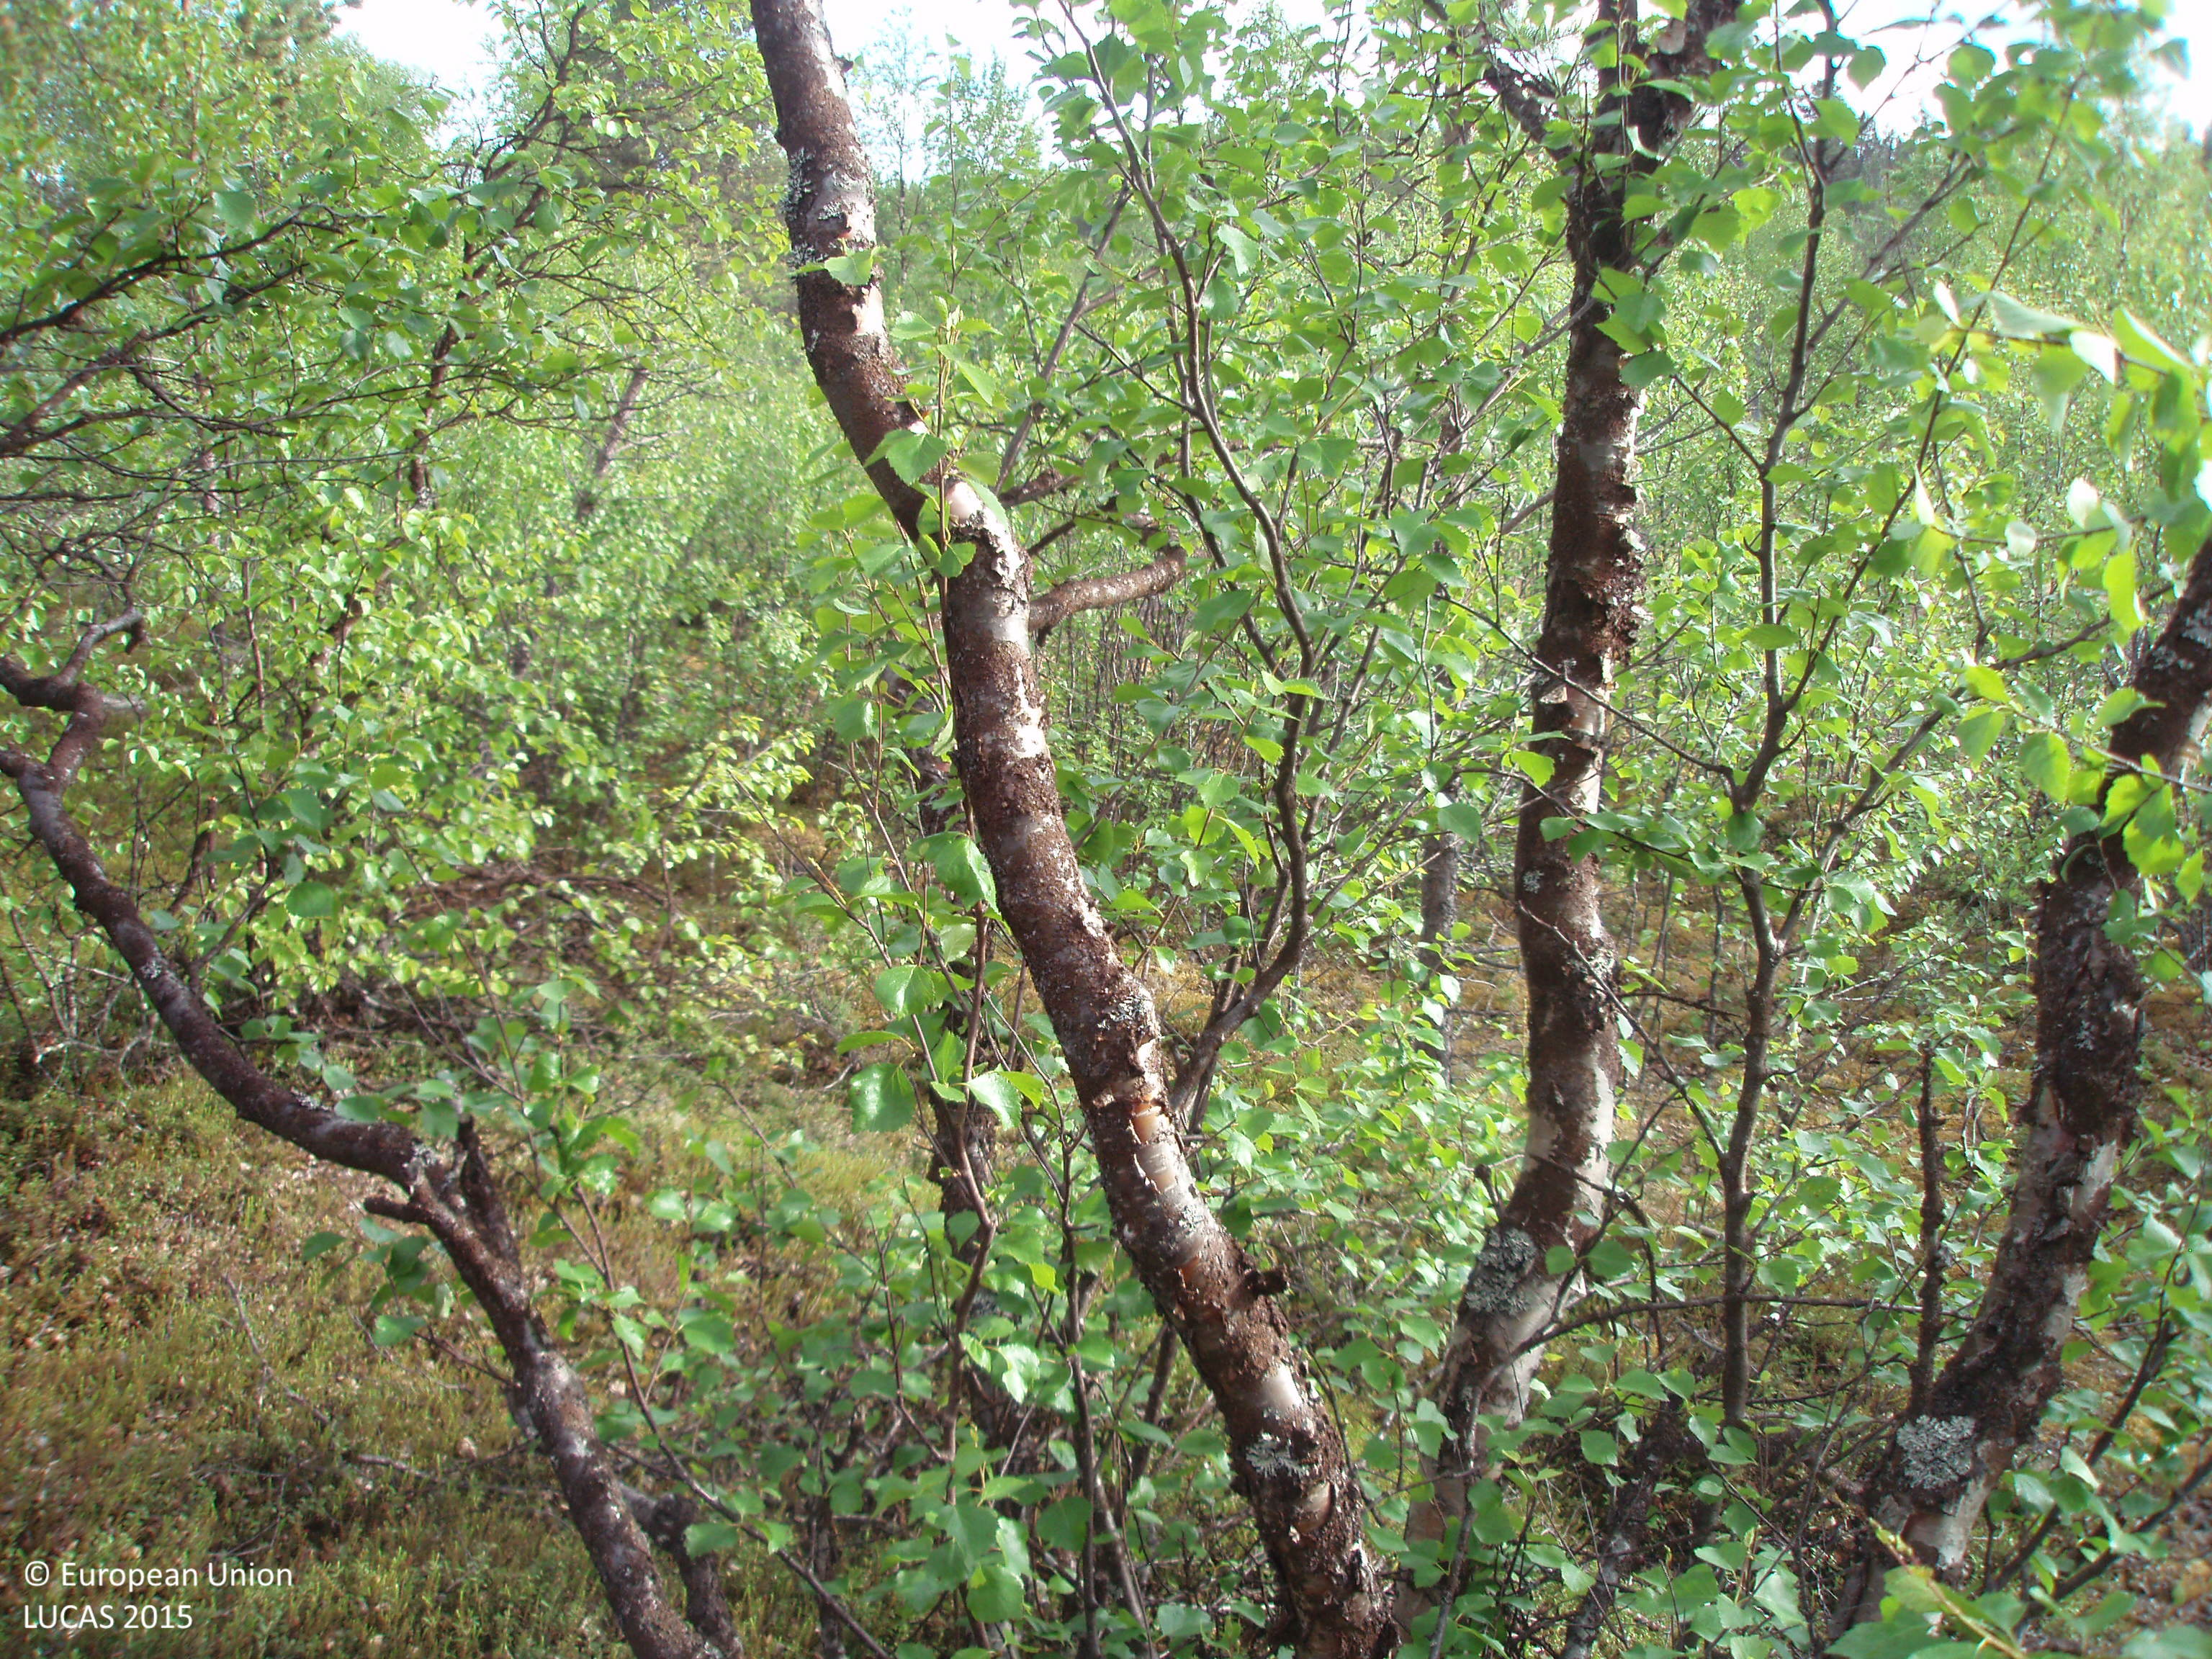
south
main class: Woodland
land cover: Pine dominated mixed woodland
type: boreal forest
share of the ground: > 75 %
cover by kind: broadleaved forest trees 60 %, coniferous forest trees 30 %, shrubs 10 %
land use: Forestry
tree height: > 5 m
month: July
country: FI
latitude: 69.0612
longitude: 25.7497
